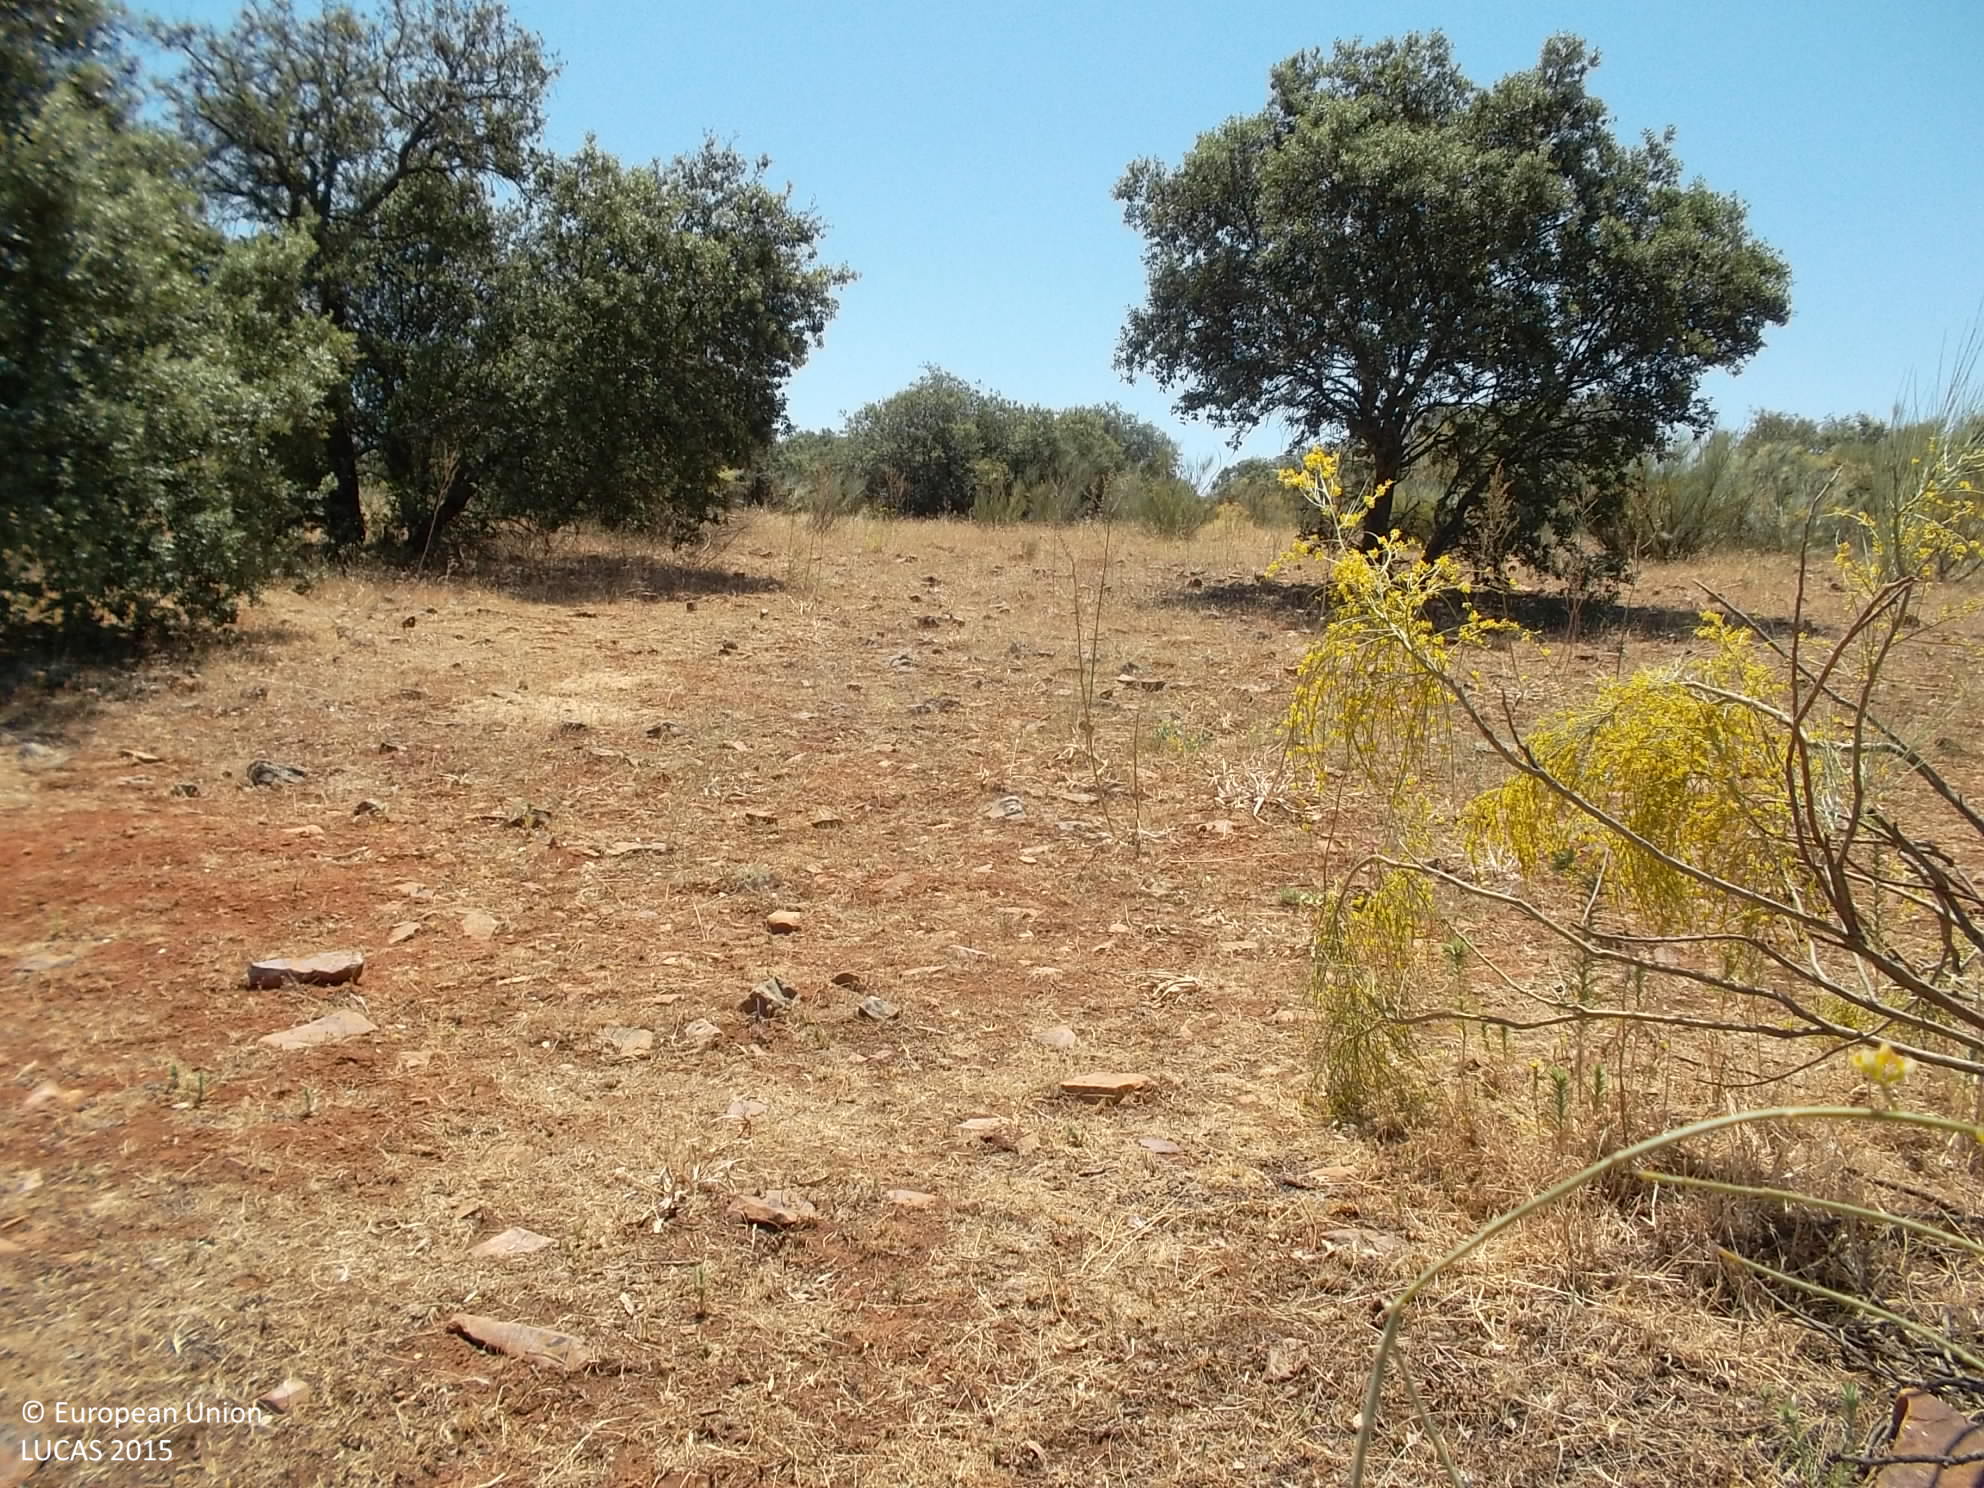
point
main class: Woodland
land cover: Broadleaved woodland
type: broadleaved evergreen forest
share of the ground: 25 - 50 %
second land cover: Spontaneously vegetated surfaces
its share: > 75 %
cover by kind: broadleaved forest trees 40 %, shrubs 30 %, herbaceous plants 30 %
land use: Forestry
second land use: Agriculture (excluding fallow land and kitchen gardens)
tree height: > 5 m
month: June
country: ES
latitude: 39.0183
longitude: -4.0087
